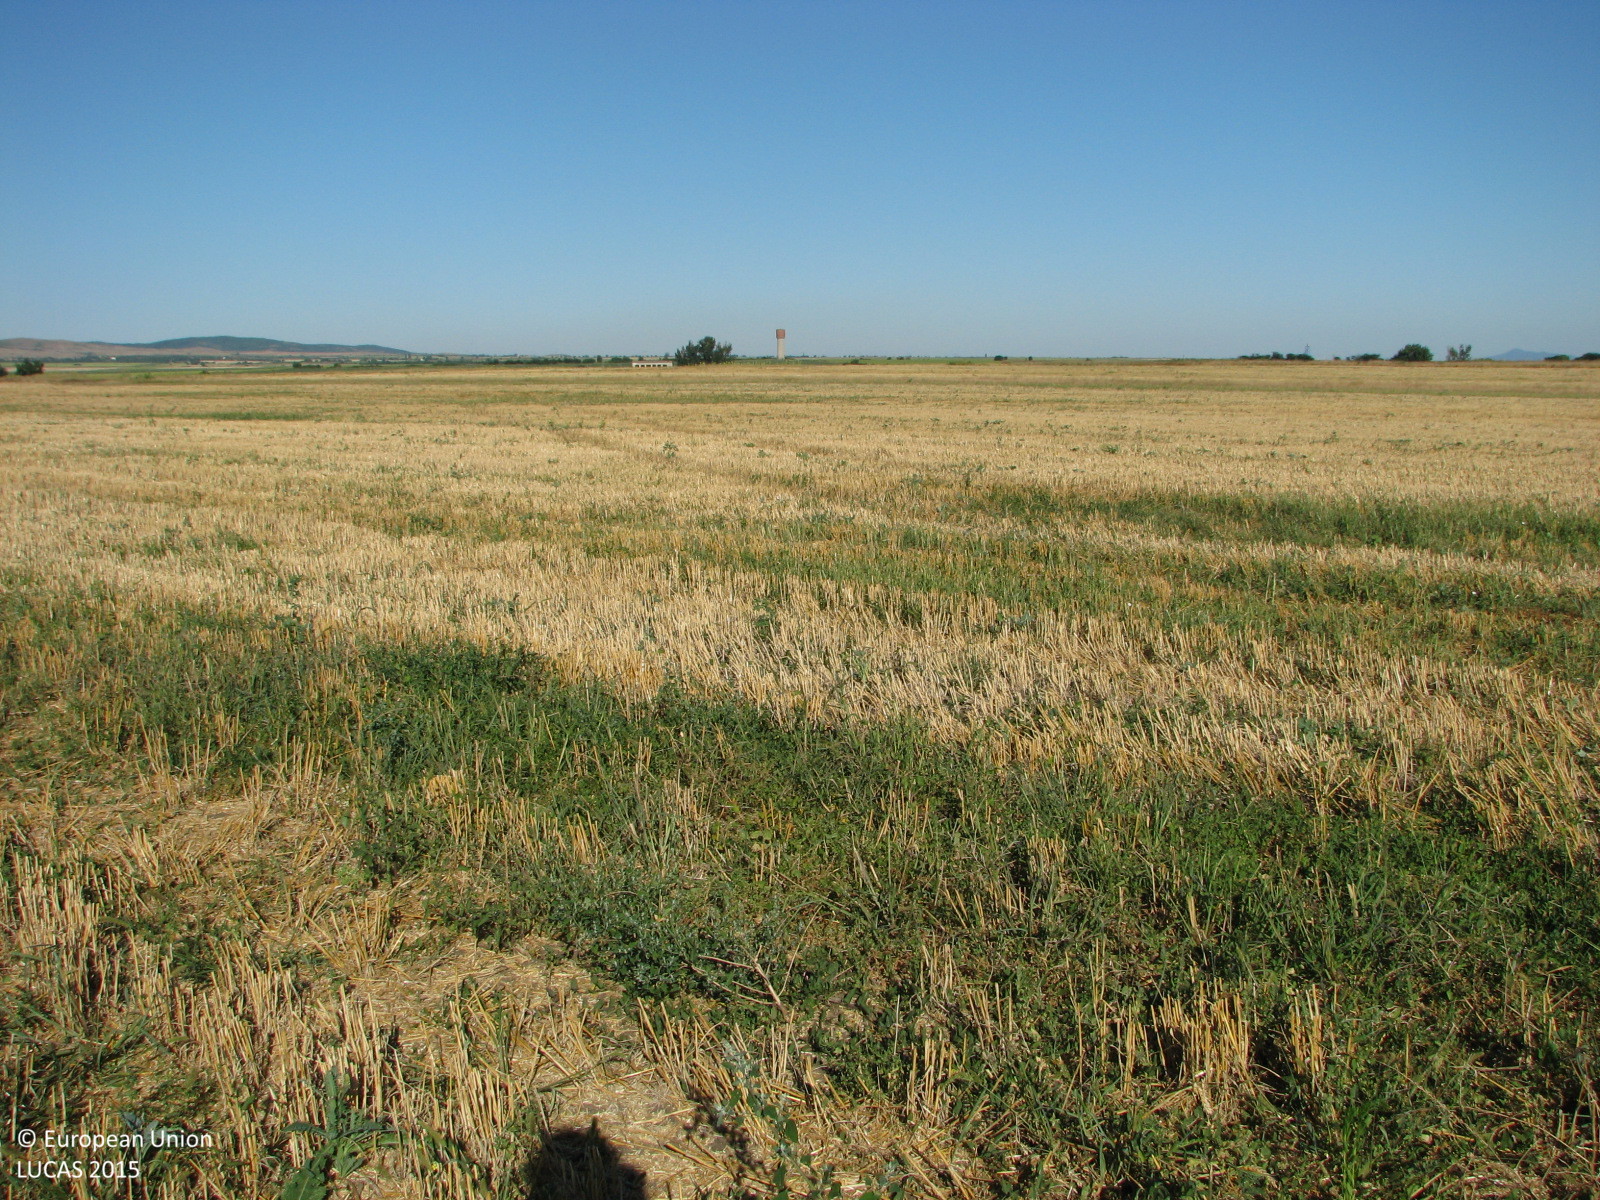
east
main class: Cropland
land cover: Common wheat
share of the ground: 10 - 25 %
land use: Agriculture (excluding fallow land and kitchen gardens)
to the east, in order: Common wheat; Tracks; Common wheat; Tracks; Grass margins; Common wheat
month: July
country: BG
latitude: 42.4040
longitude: 25.9836
